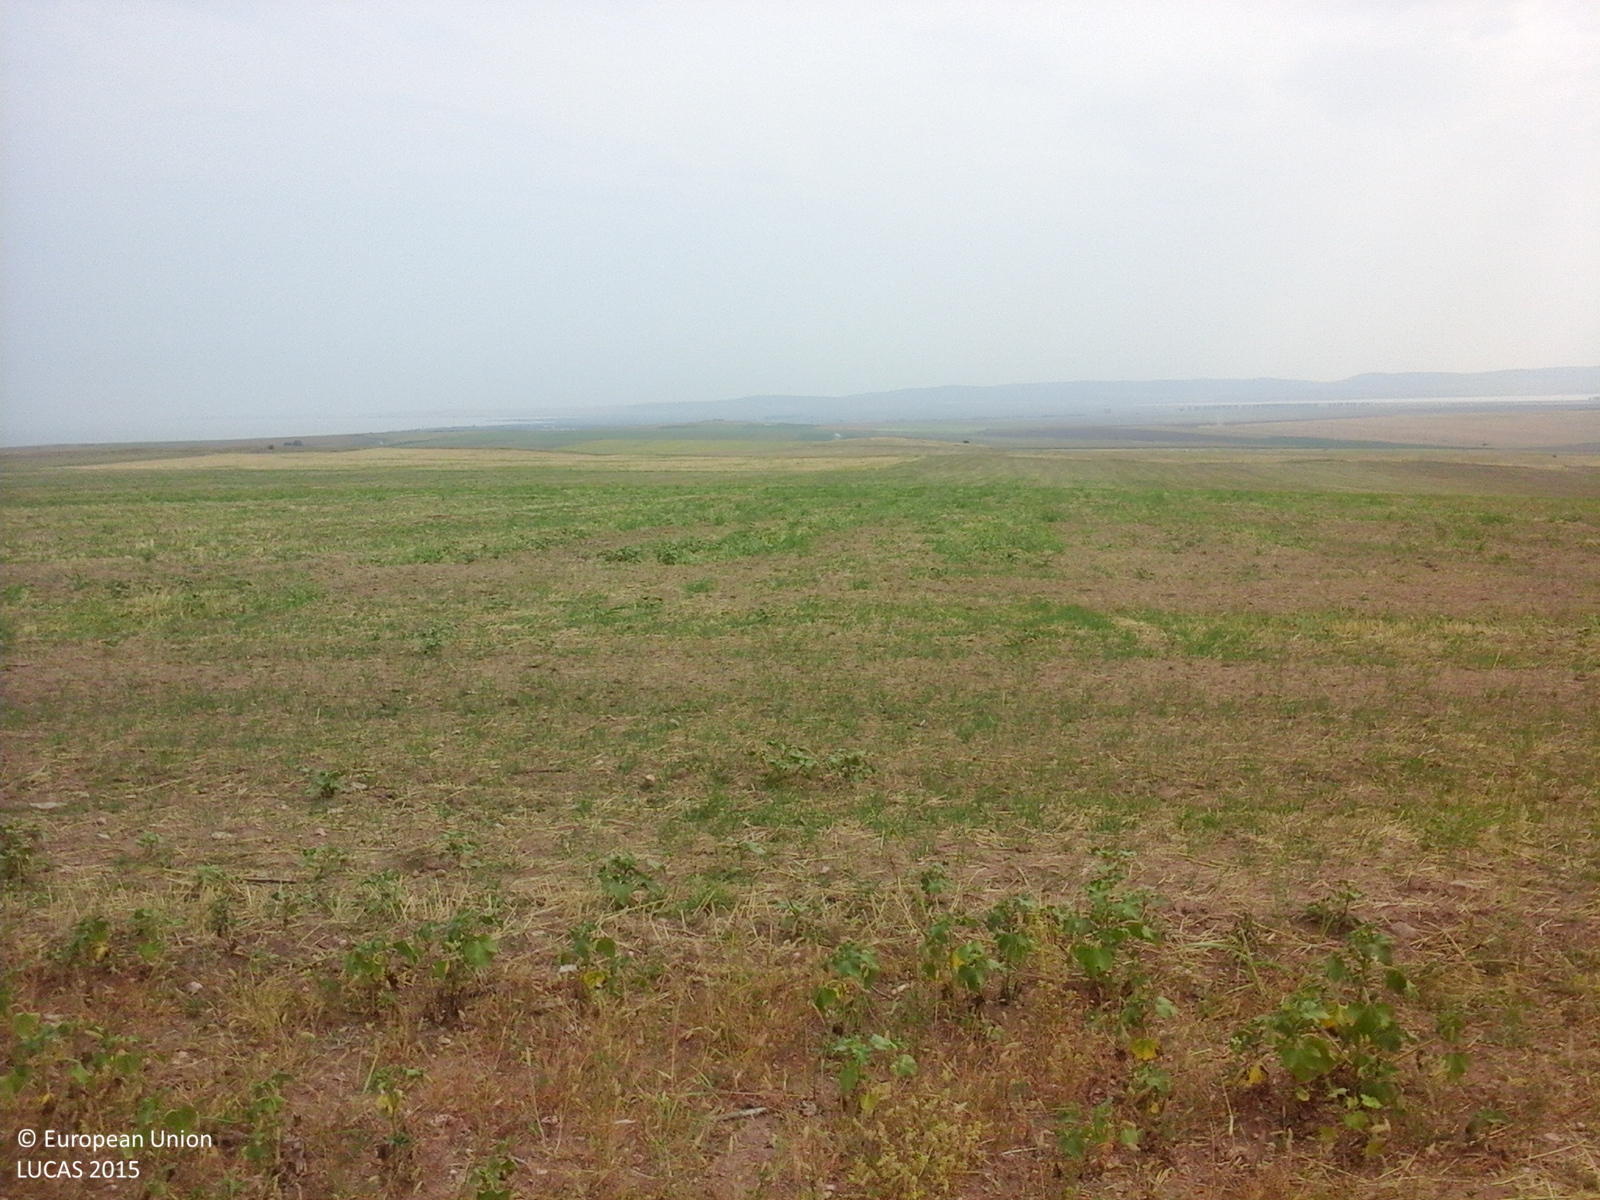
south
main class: Grassland
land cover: Spontaneously vegetated surfaces
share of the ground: 50 - 75 %
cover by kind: herbaceous plants 100 %
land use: Fallow land
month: July
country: RO
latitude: 45.0101
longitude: 28.8297
